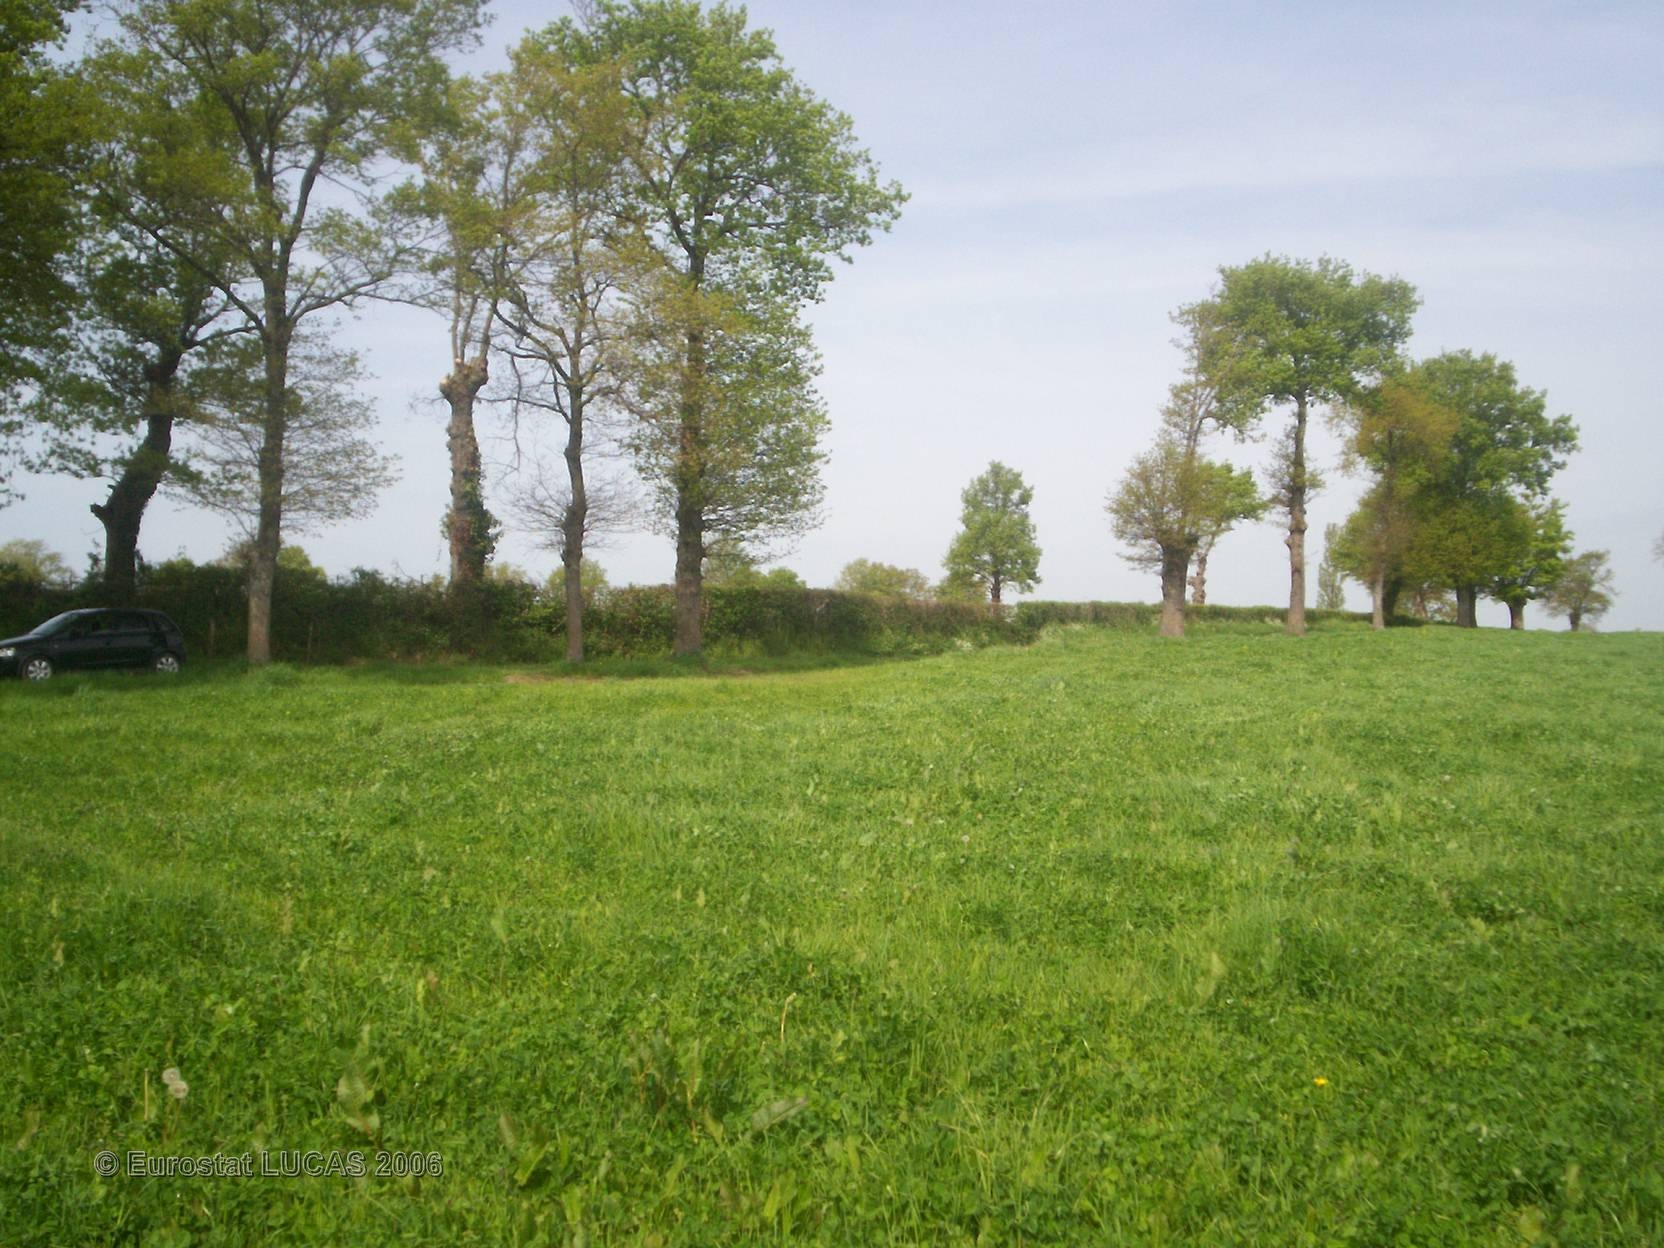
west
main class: Grassland
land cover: Grassland without tree/shrub cover
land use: Agriculture (excluding fallow land and kitchen gardens)
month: May
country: FR
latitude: 46.5635
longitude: 3.1225
